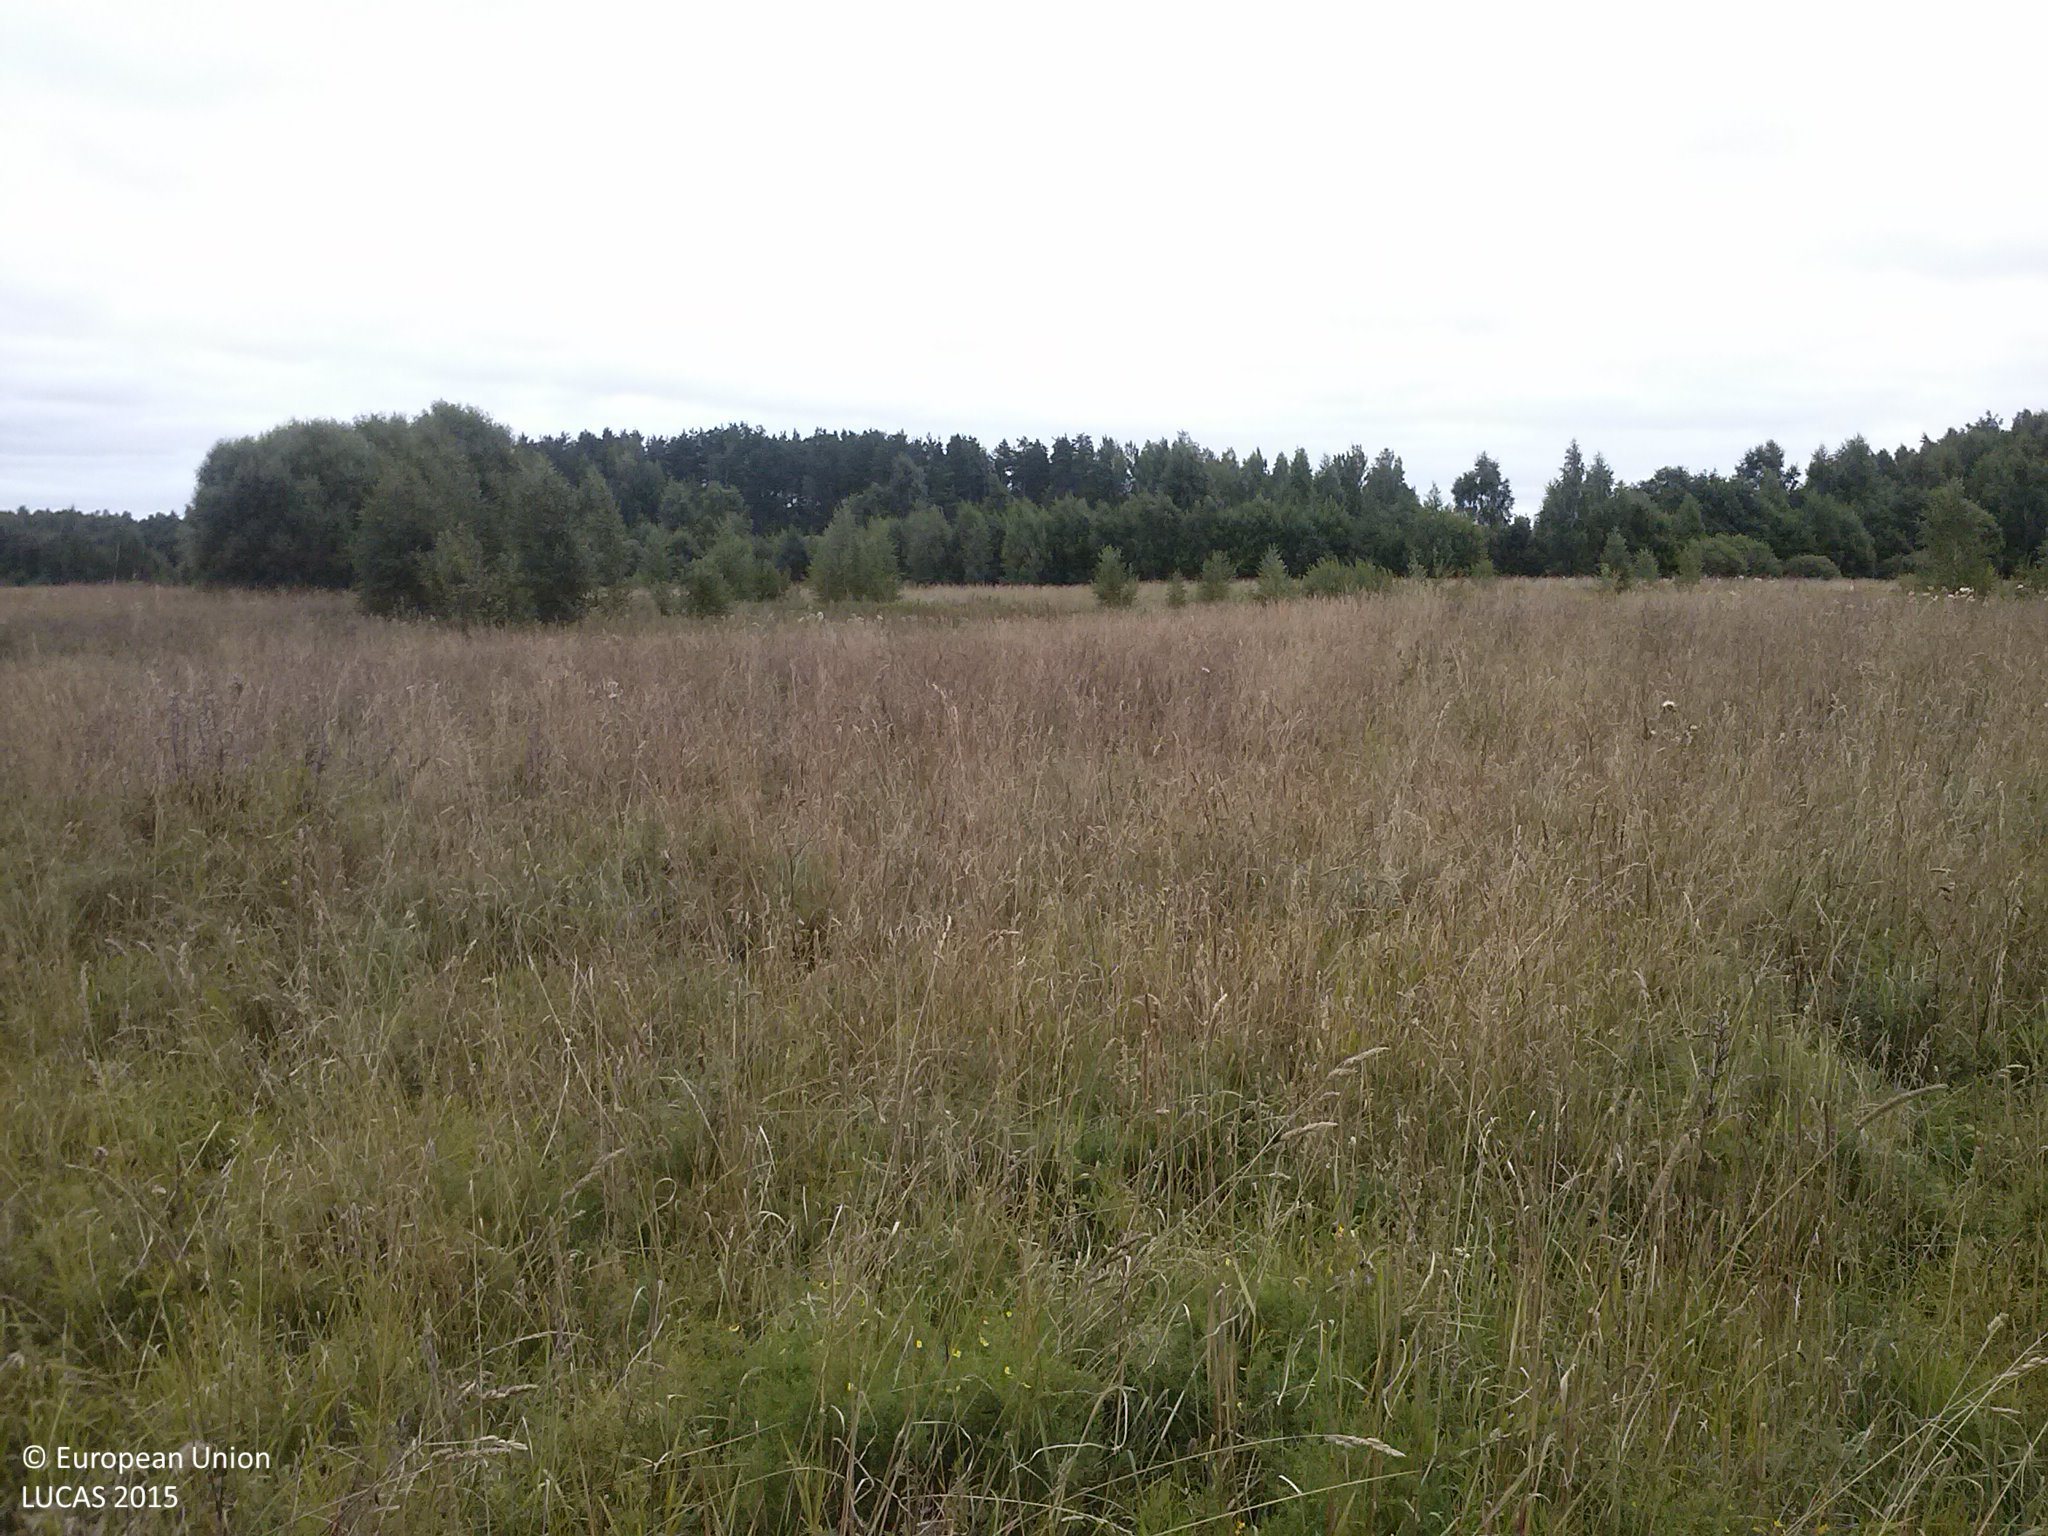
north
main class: Cropland
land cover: Oats
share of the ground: > 75 %
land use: Agriculture (excluding fallow land and kitchen gardens)
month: August
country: LV
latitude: 56.1992
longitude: 26.7417
